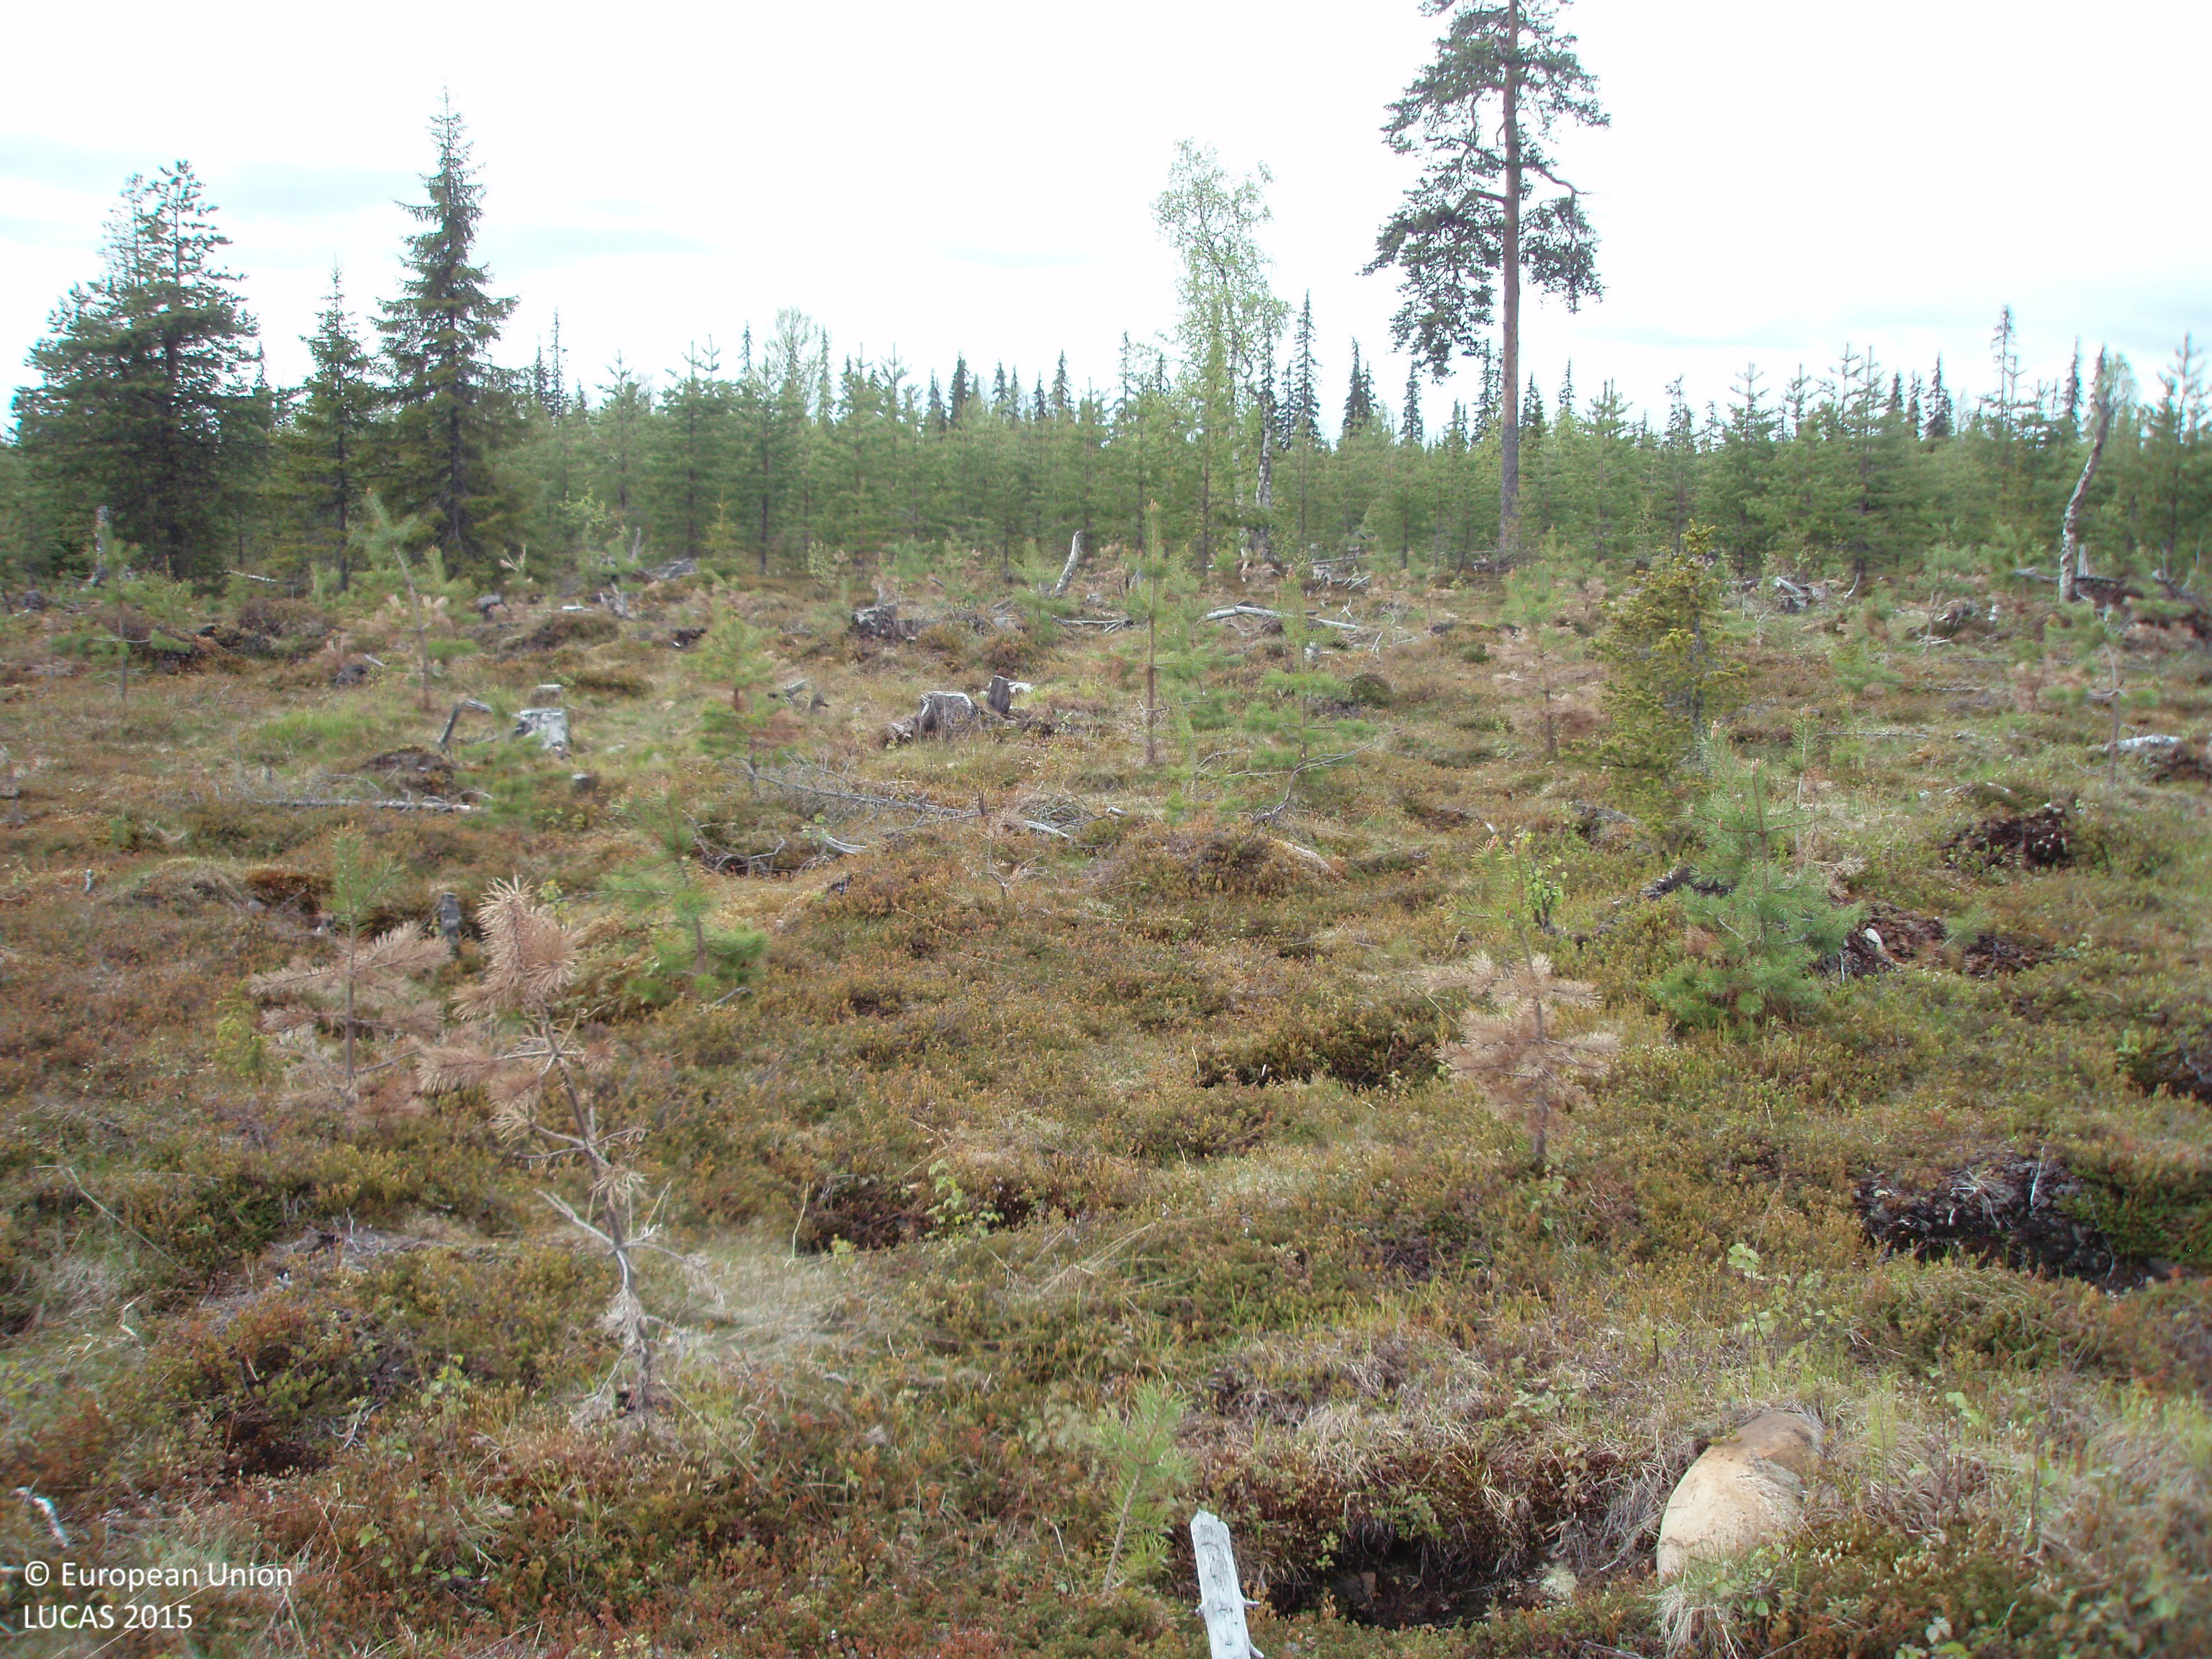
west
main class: Shrubland
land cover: Shrubland with sparse tree cover
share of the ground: 50 - 75 %
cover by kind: shrubs 55 %, herbaceous plants 40 %, coniferous forest trees 5 %
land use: Forestry
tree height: < 5 m
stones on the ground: < 10 %
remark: Clear cut
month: June
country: FI
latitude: 67.9450
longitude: 26.9470
